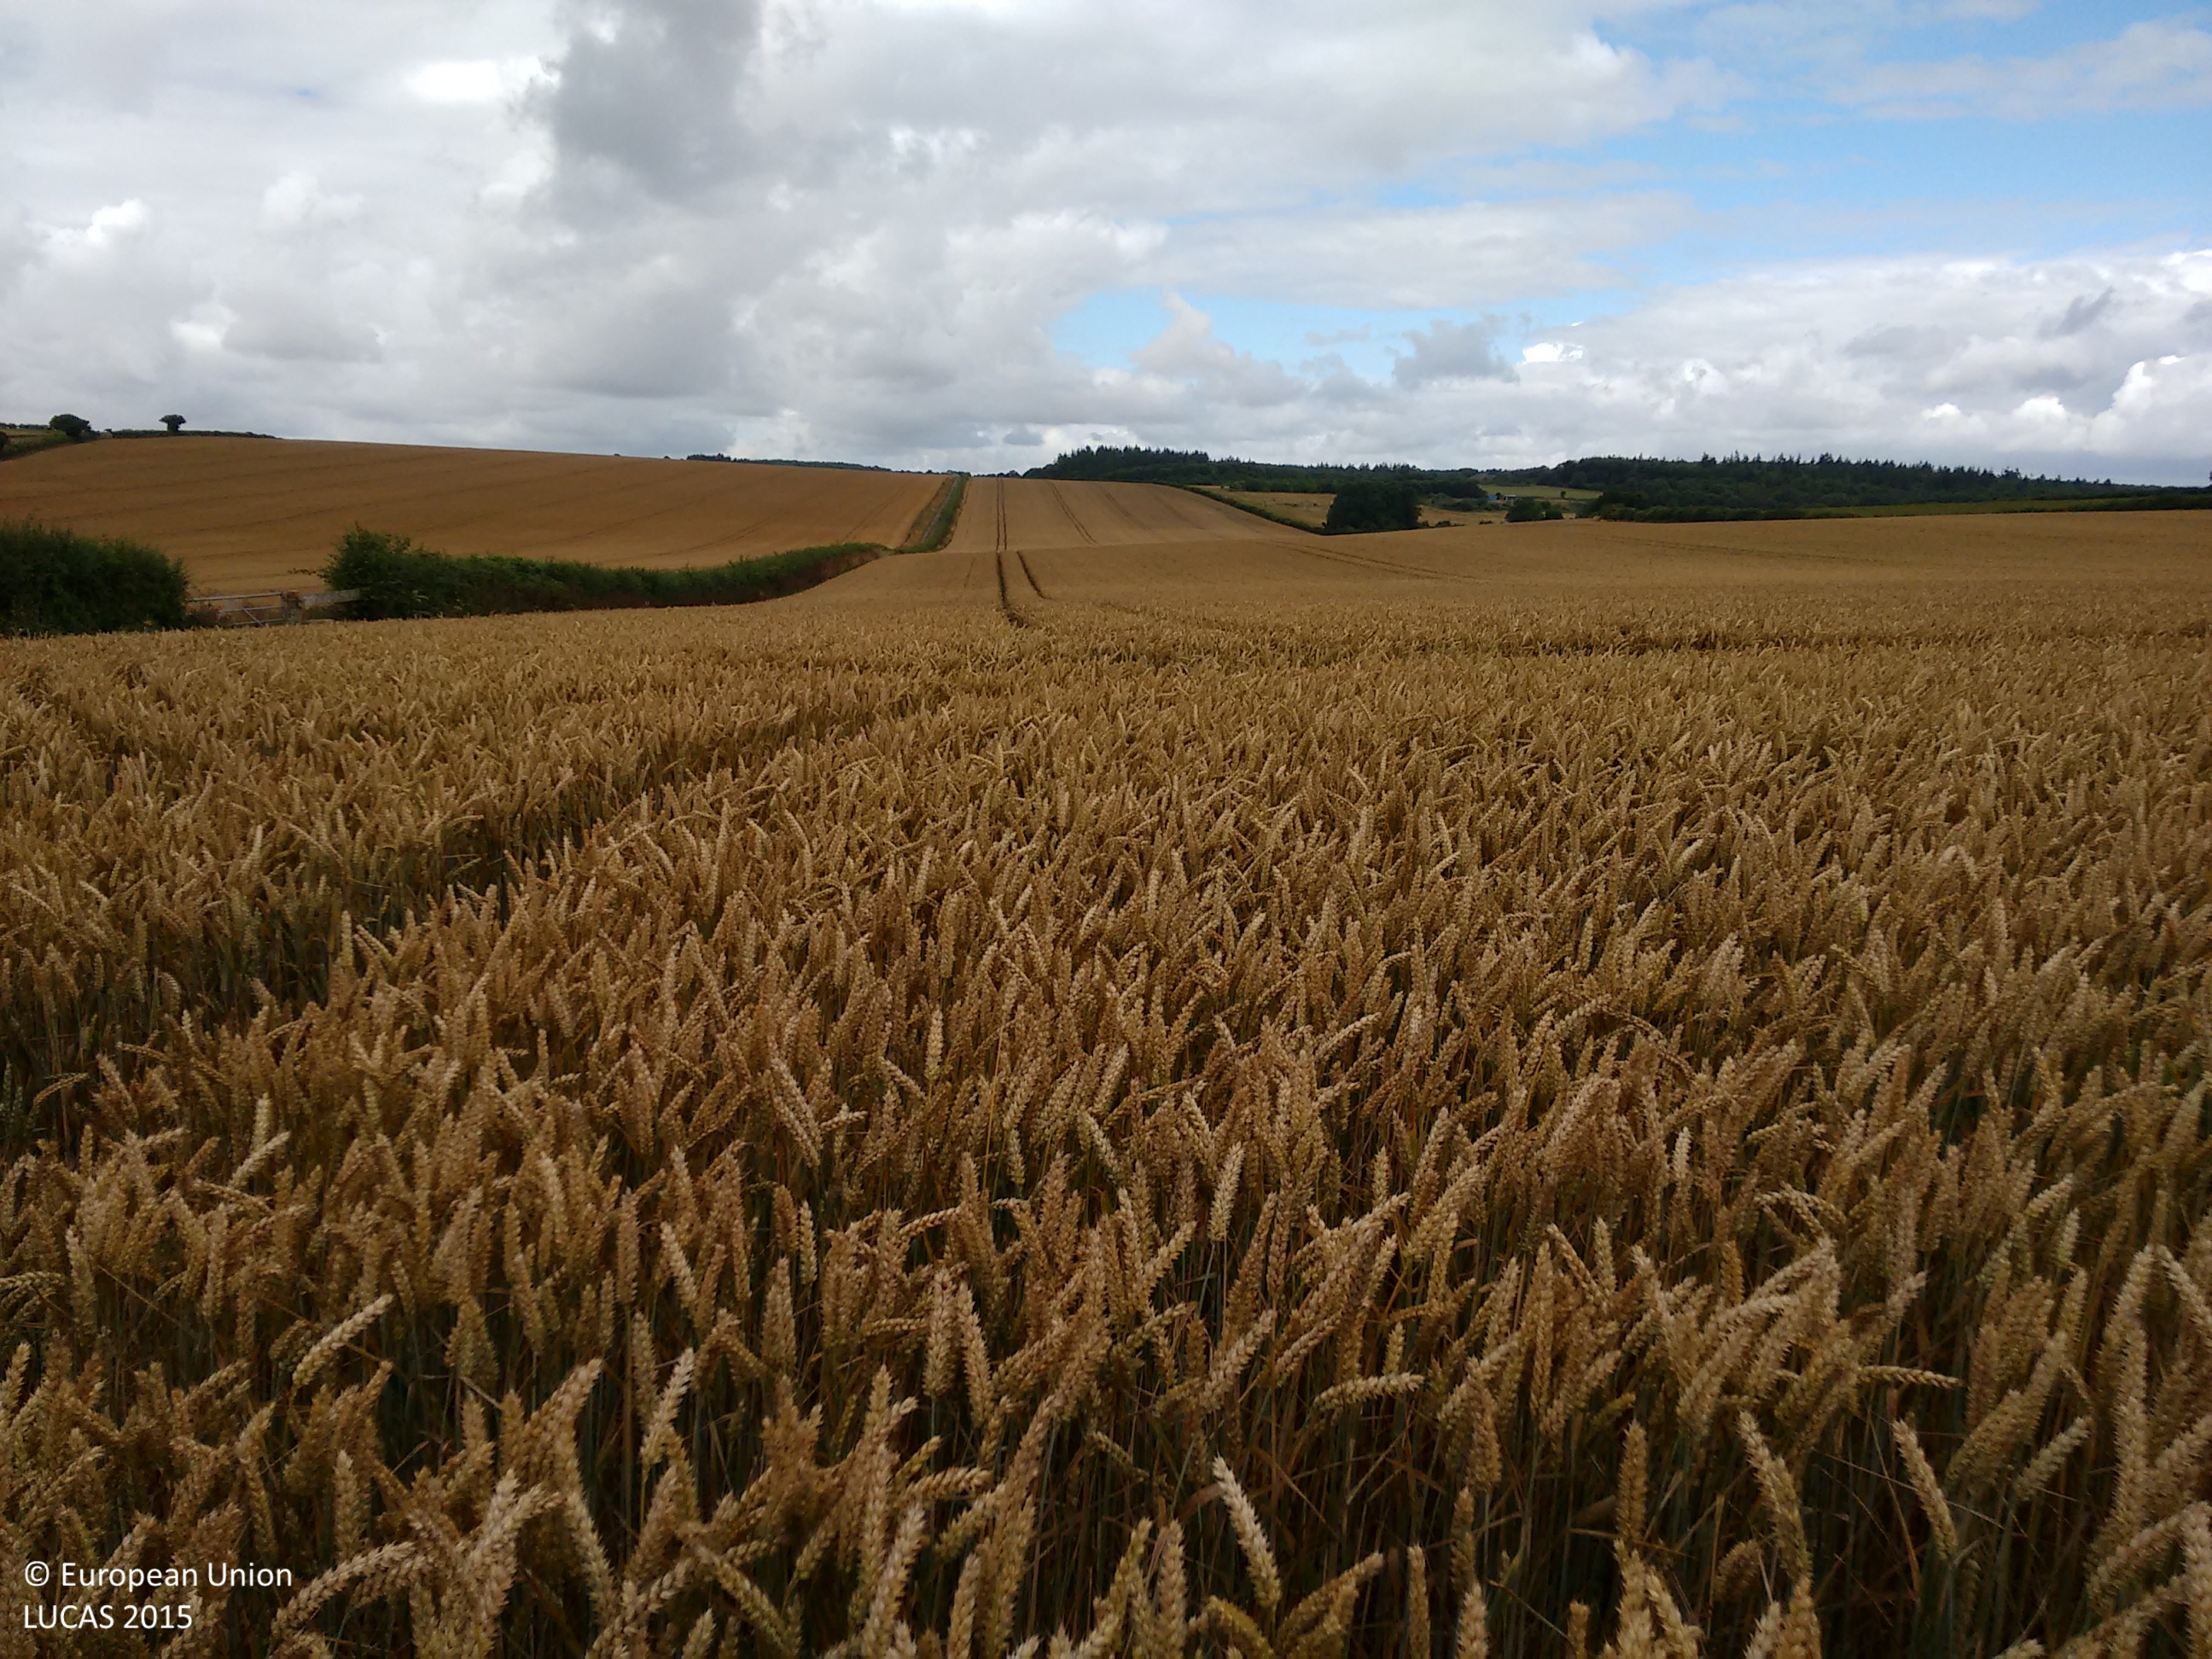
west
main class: Cropland
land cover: Common wheat
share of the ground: > 75 %
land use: Agriculture (excluding fallow land and kitchen gardens)
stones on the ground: 25 - 50 %
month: July
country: GB
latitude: 50.8652
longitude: -2.0943
